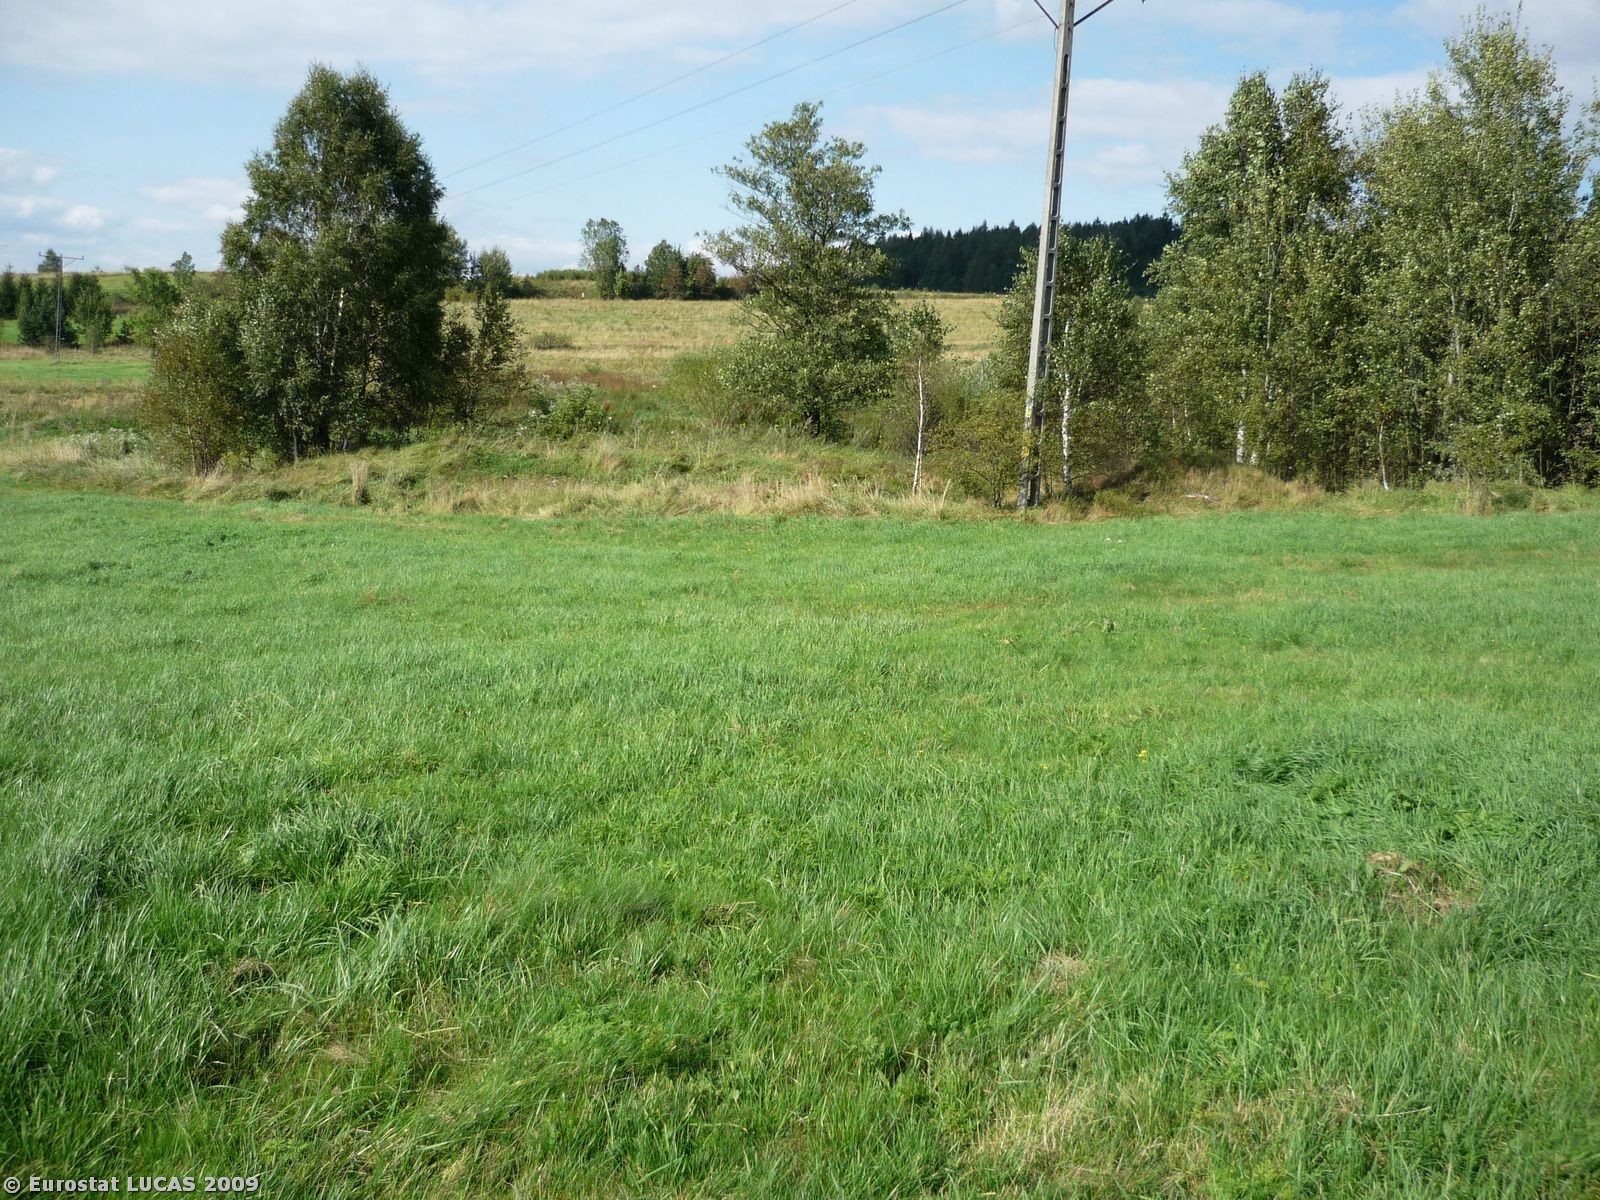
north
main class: Grassland
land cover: Grassland without tree/shrub cover
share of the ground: > 75 %
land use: Agriculture (excluding fallow land and kitchen gardens)
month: September
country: PL
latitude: 50.7251
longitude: 16.0833
